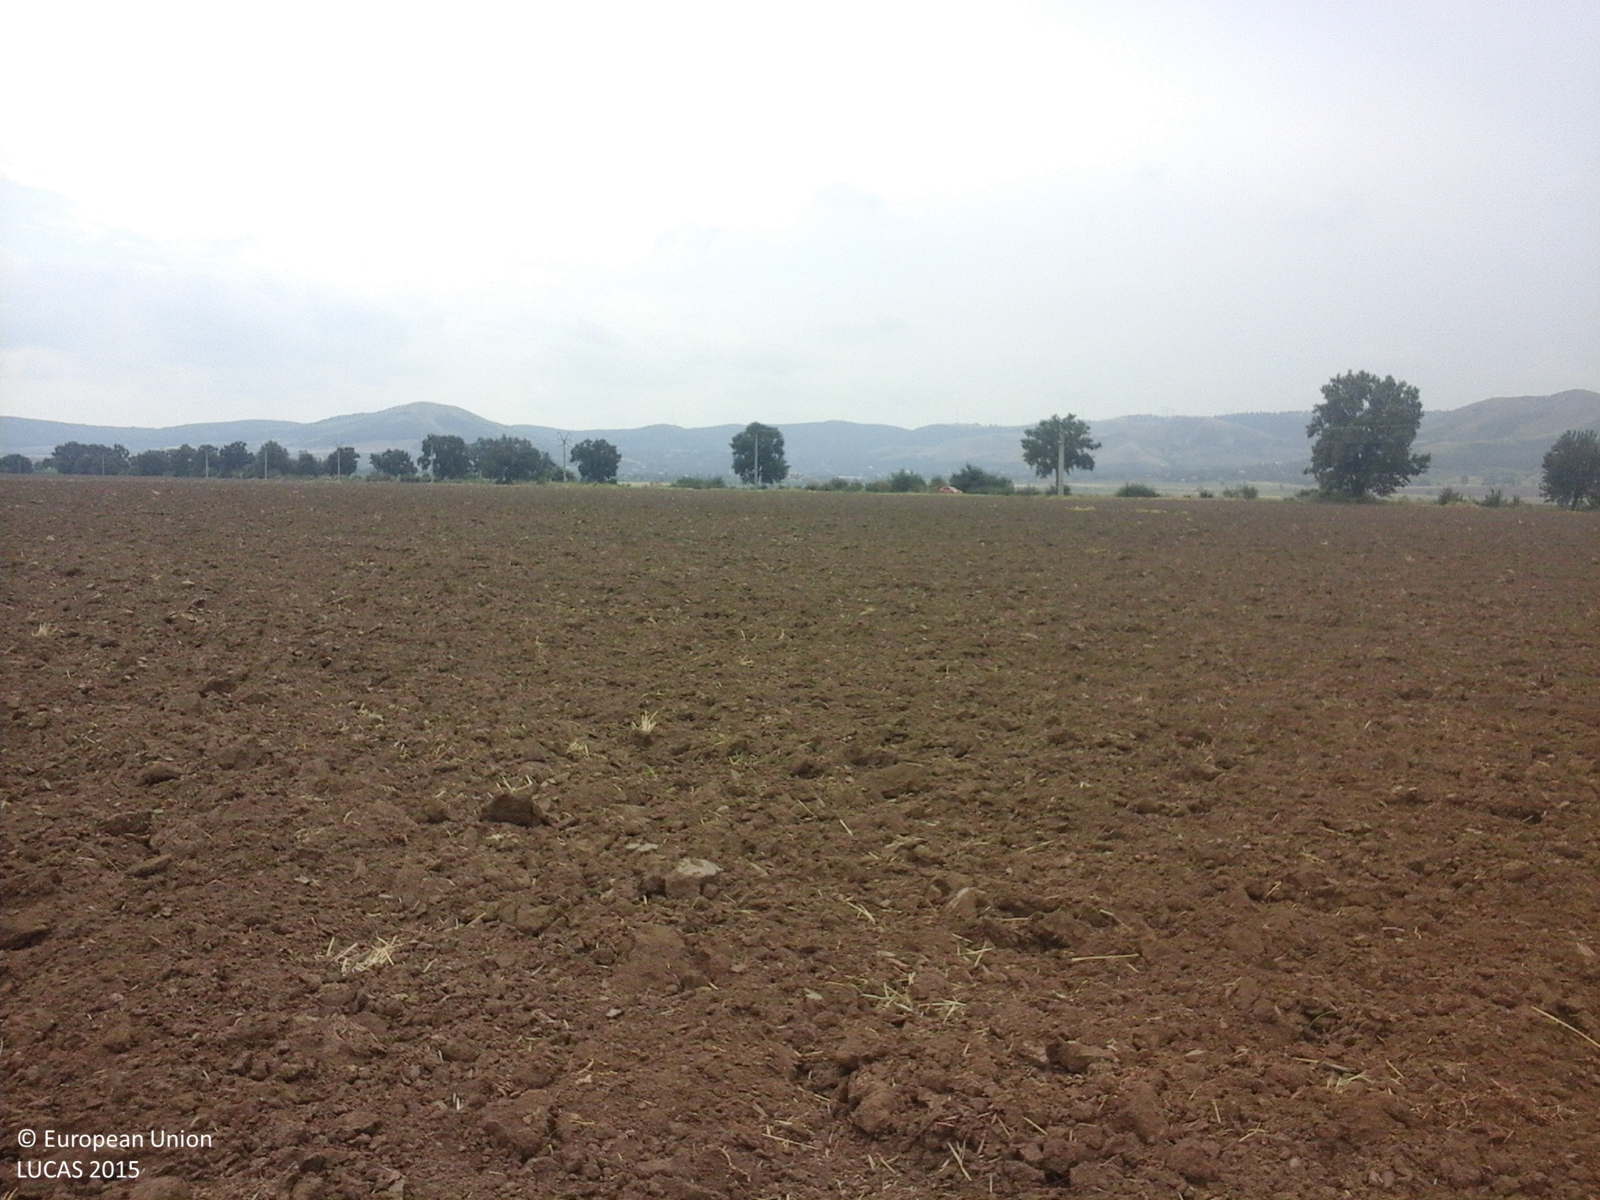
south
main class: Cropland
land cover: Common wheat
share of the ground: < 10 %
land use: Agriculture (excluding fallow land and kitchen gardens)
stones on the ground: < 10 %
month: July
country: RO
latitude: 45.2208
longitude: 28.4815
